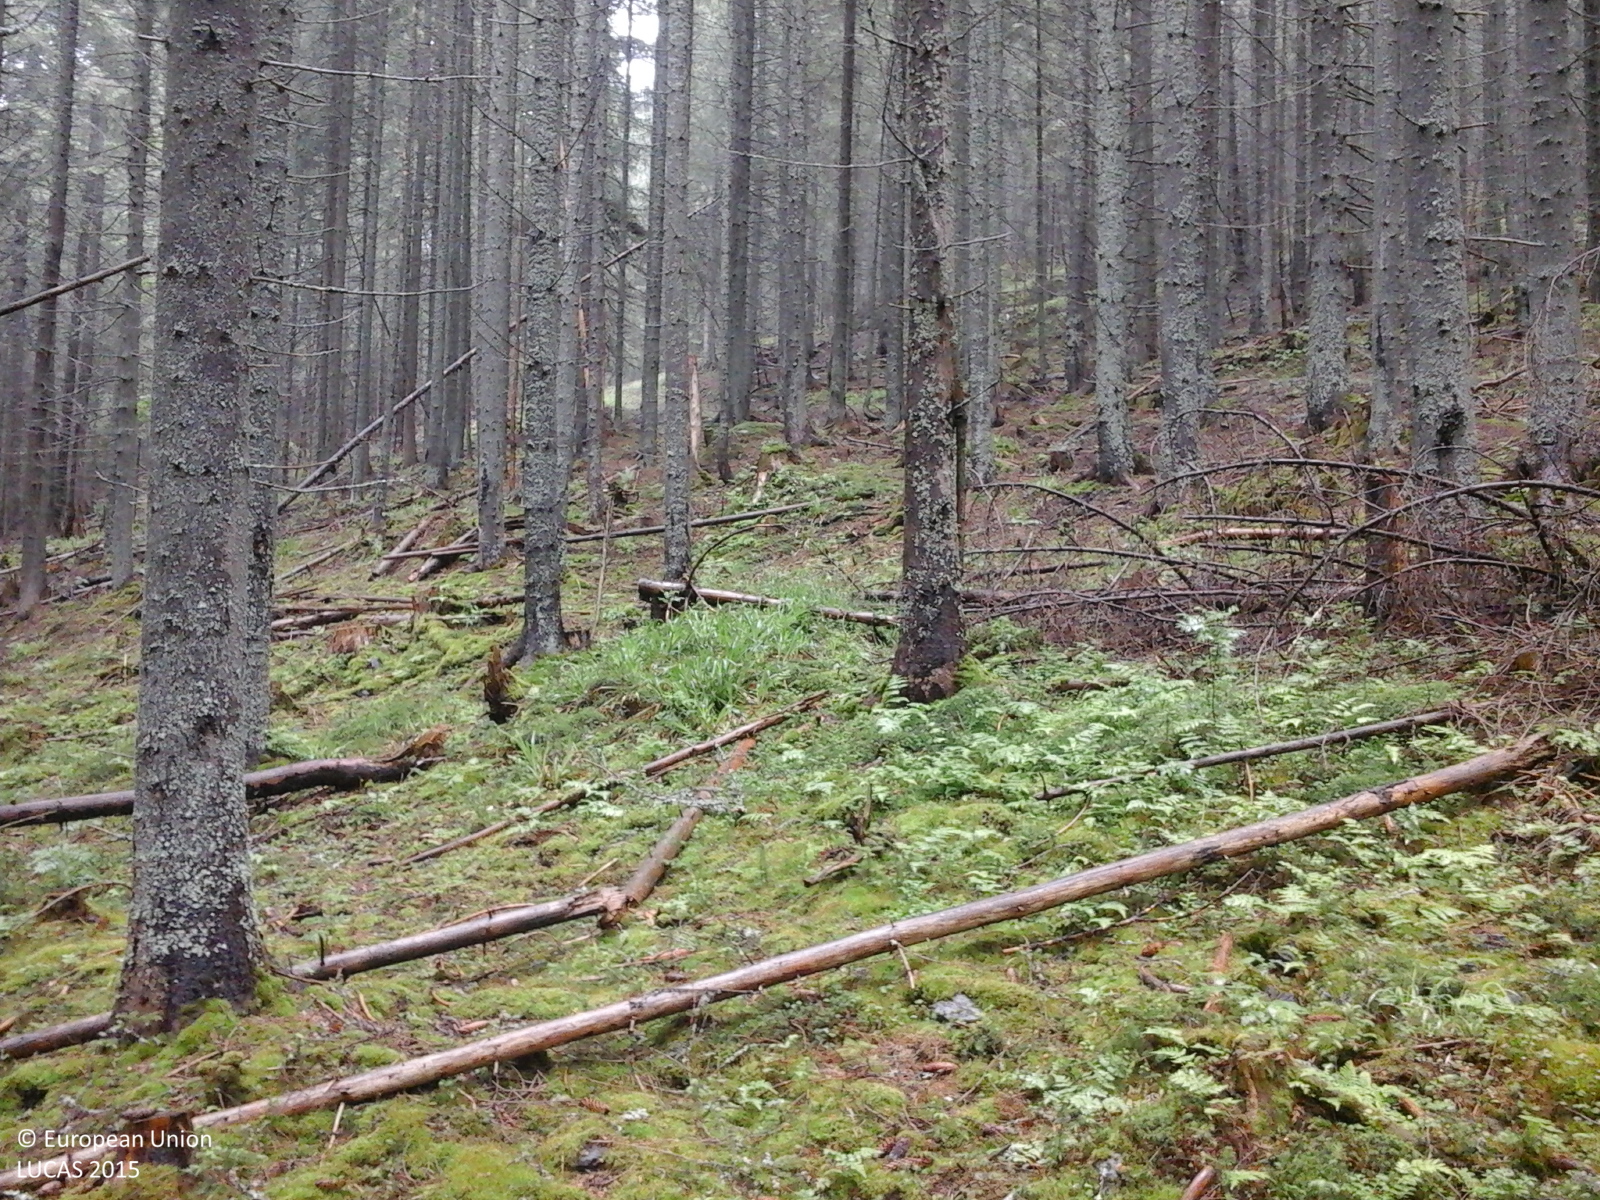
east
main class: Woodland
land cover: Spruce dominated coniferous woodland
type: alpine coniferous forest
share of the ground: > 75 %
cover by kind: coniferous forest trees 90 %, herbaceous plants 5 %, lichens and mosses 5 %
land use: Forestry
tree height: > 5 m
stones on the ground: 10 - 25 %
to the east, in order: Spruce dominated coniferous woodland; Tracks; Spruce dominated coniferous woodland; Tracks; Spruce dominated coniferous woodland
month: June
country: RO
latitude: 47.4162
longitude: 25.3407
